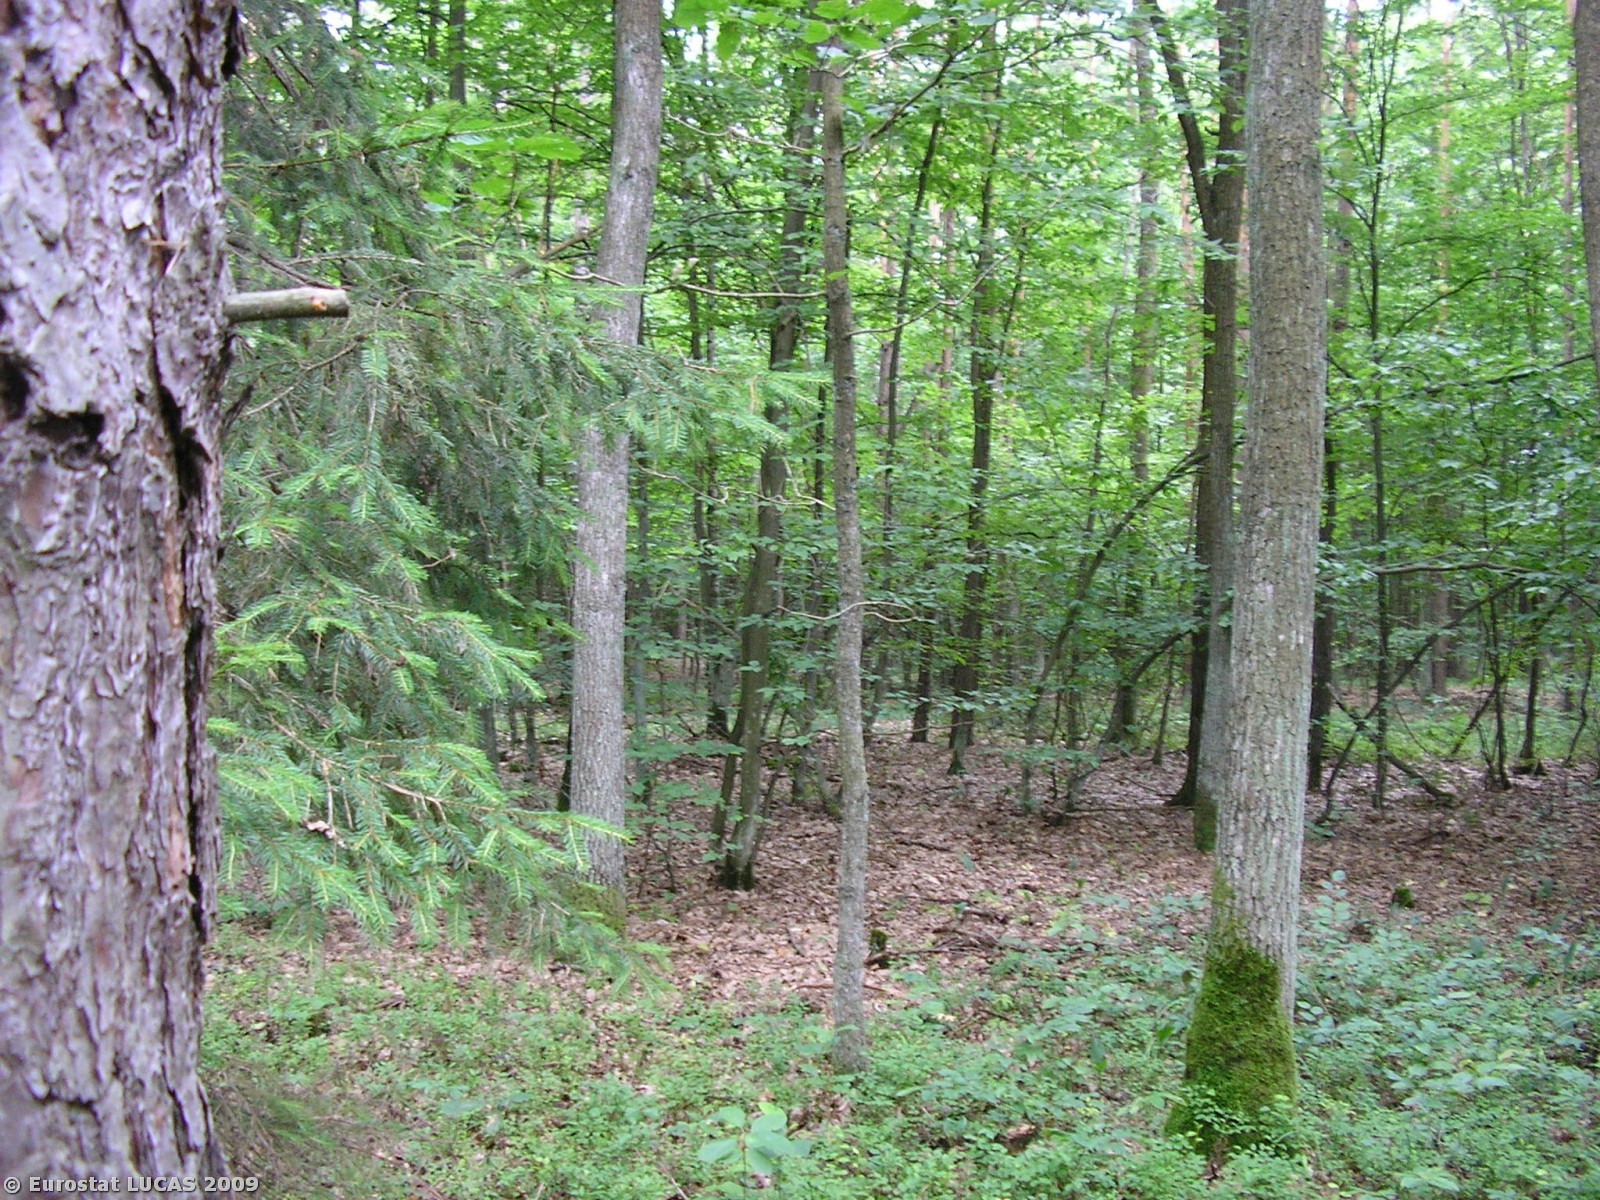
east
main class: Woodland
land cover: Mixed woodland
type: hemiboreal forest and nemoral coniferous forest and mixed broadleaved-coniferous forest
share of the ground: > 75 %
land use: Forestry
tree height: > 5 m
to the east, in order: Mixed woodland; Tracks; Mixed woodland; Ditches and canals; Mixed woodland; Grass margins; Tracks; Grass margins; Mixed woodland
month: July
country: PL
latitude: 51.4922
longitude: 21.4724
